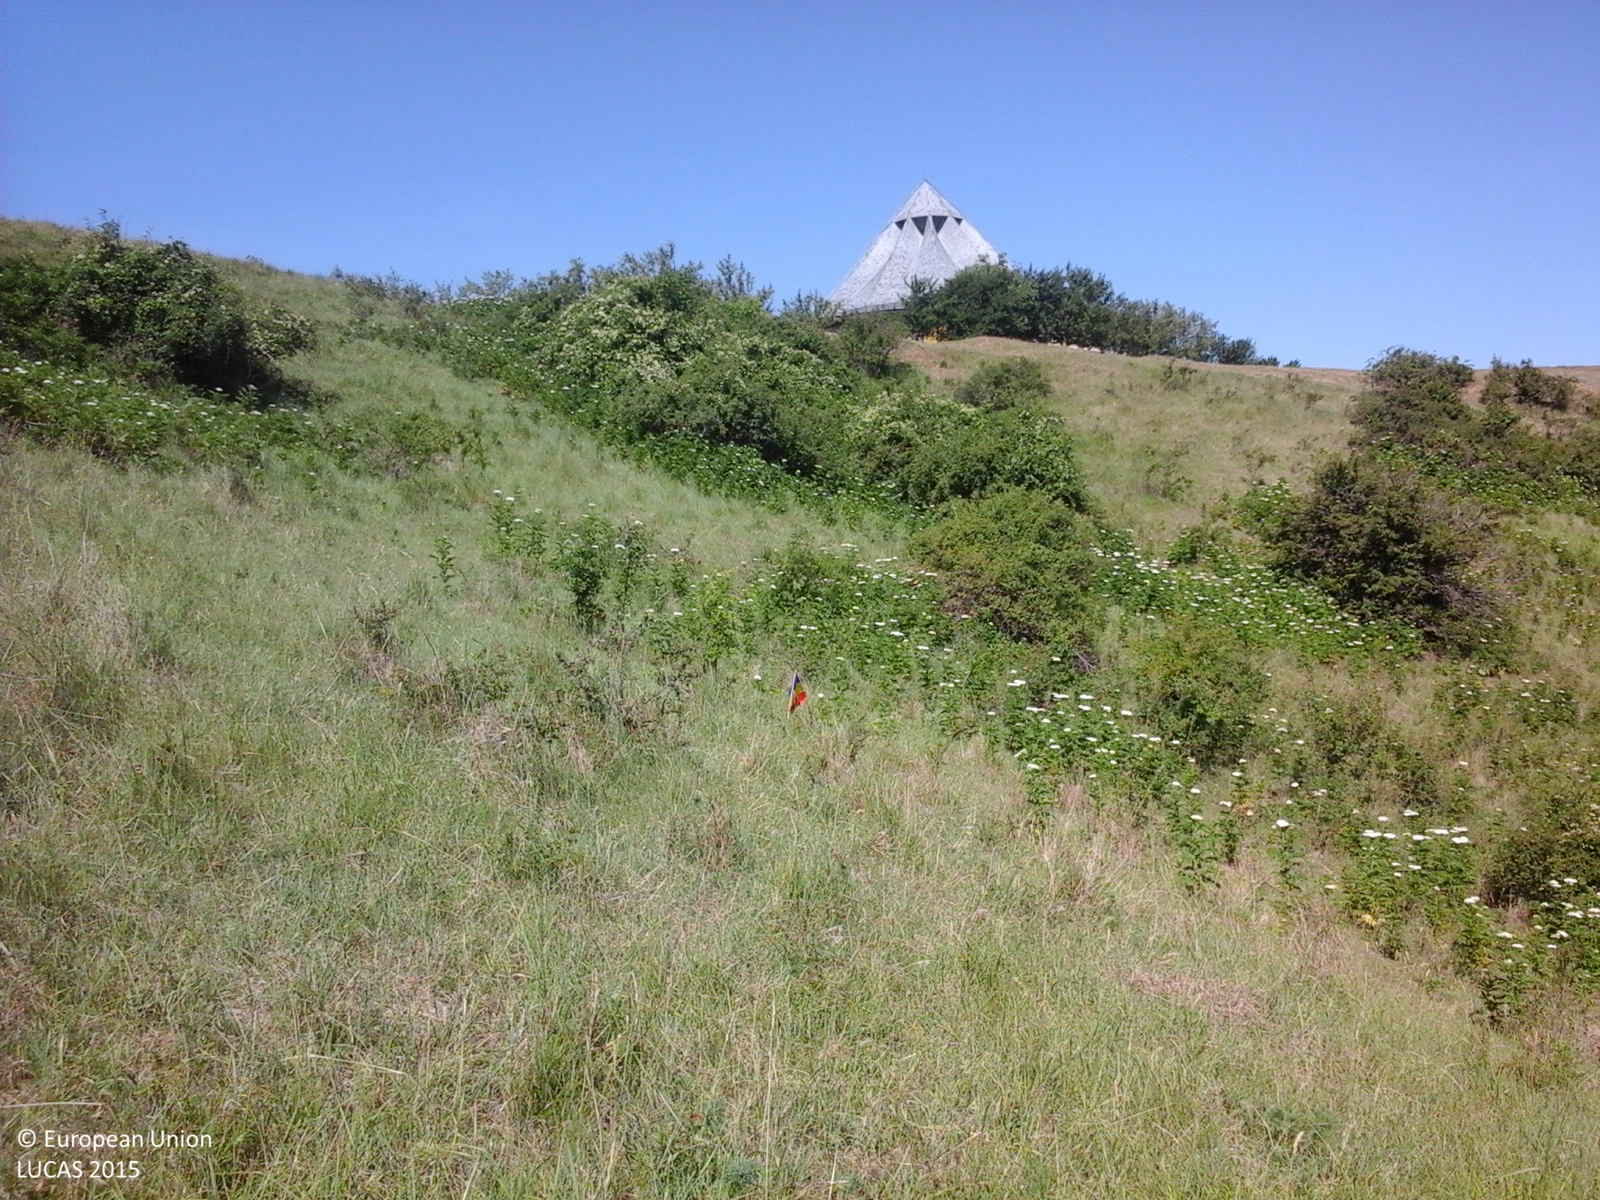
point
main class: Shrubland
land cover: Shrubland without tree cover
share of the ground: > 75 %
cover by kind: shrubs 80 %, herbaceous plants 20 %
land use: Fallow land
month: June
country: RO
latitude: 47.2871
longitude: 26.9313
